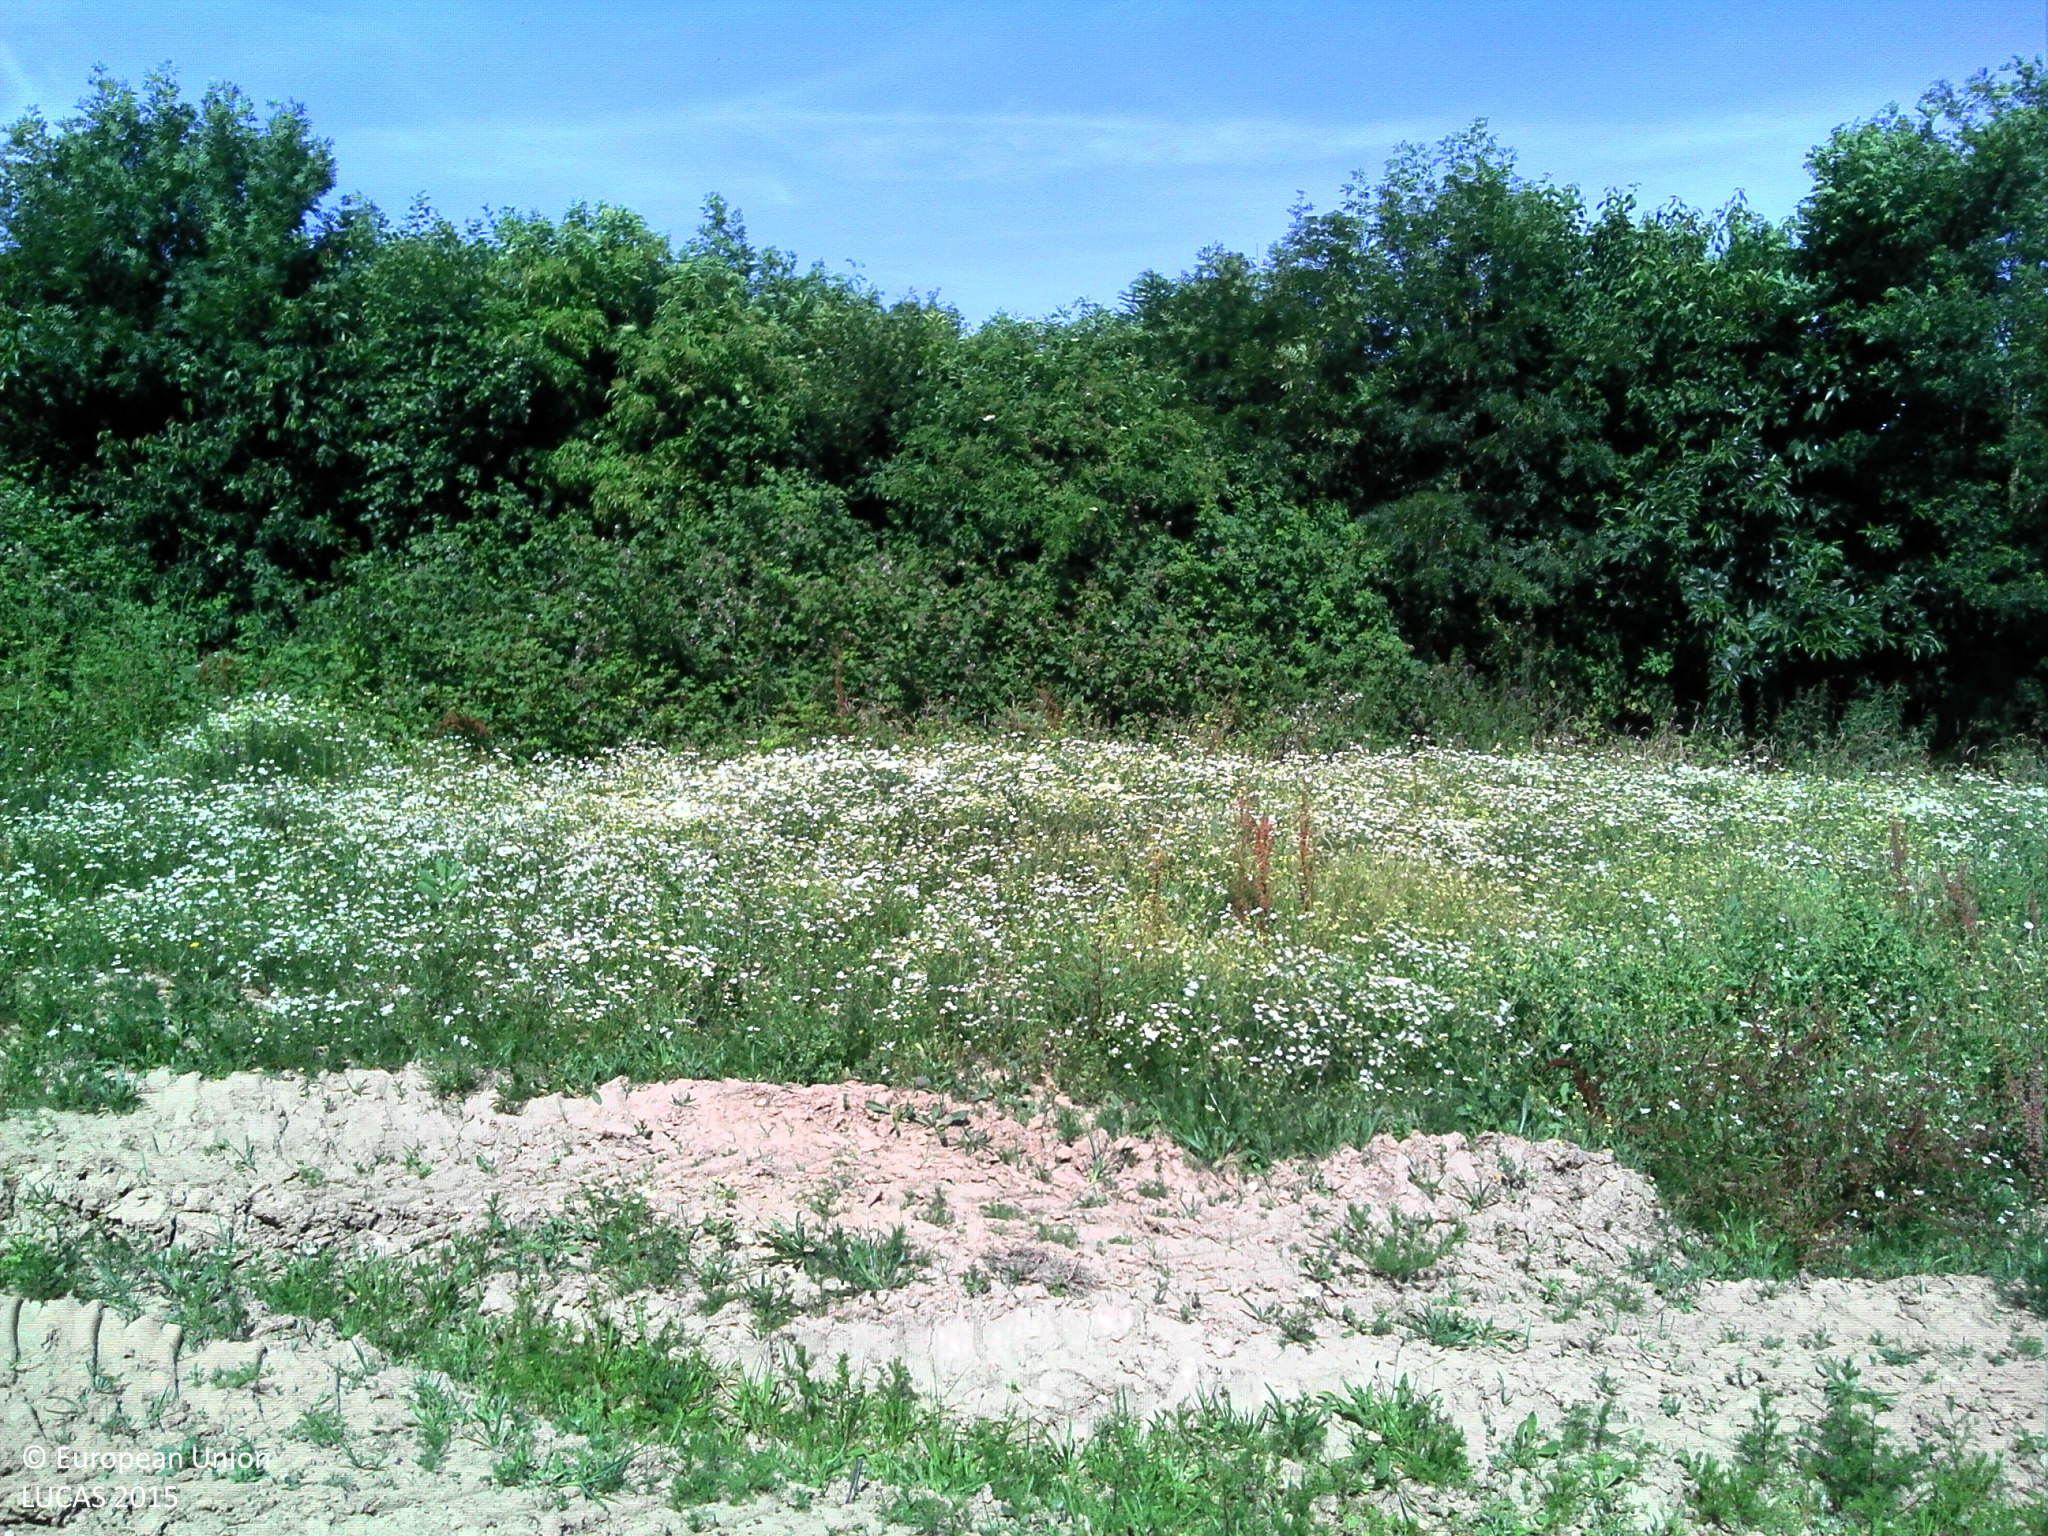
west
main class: Grassland
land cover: Spontaneously vegetated surfaces
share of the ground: > 75 %
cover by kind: herbaceous plants 95 %, unconsolidated bare surface 5 %
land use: Semi-natural and natural areas not in use
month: June
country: FR
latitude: 47.1962
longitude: -2.0470
